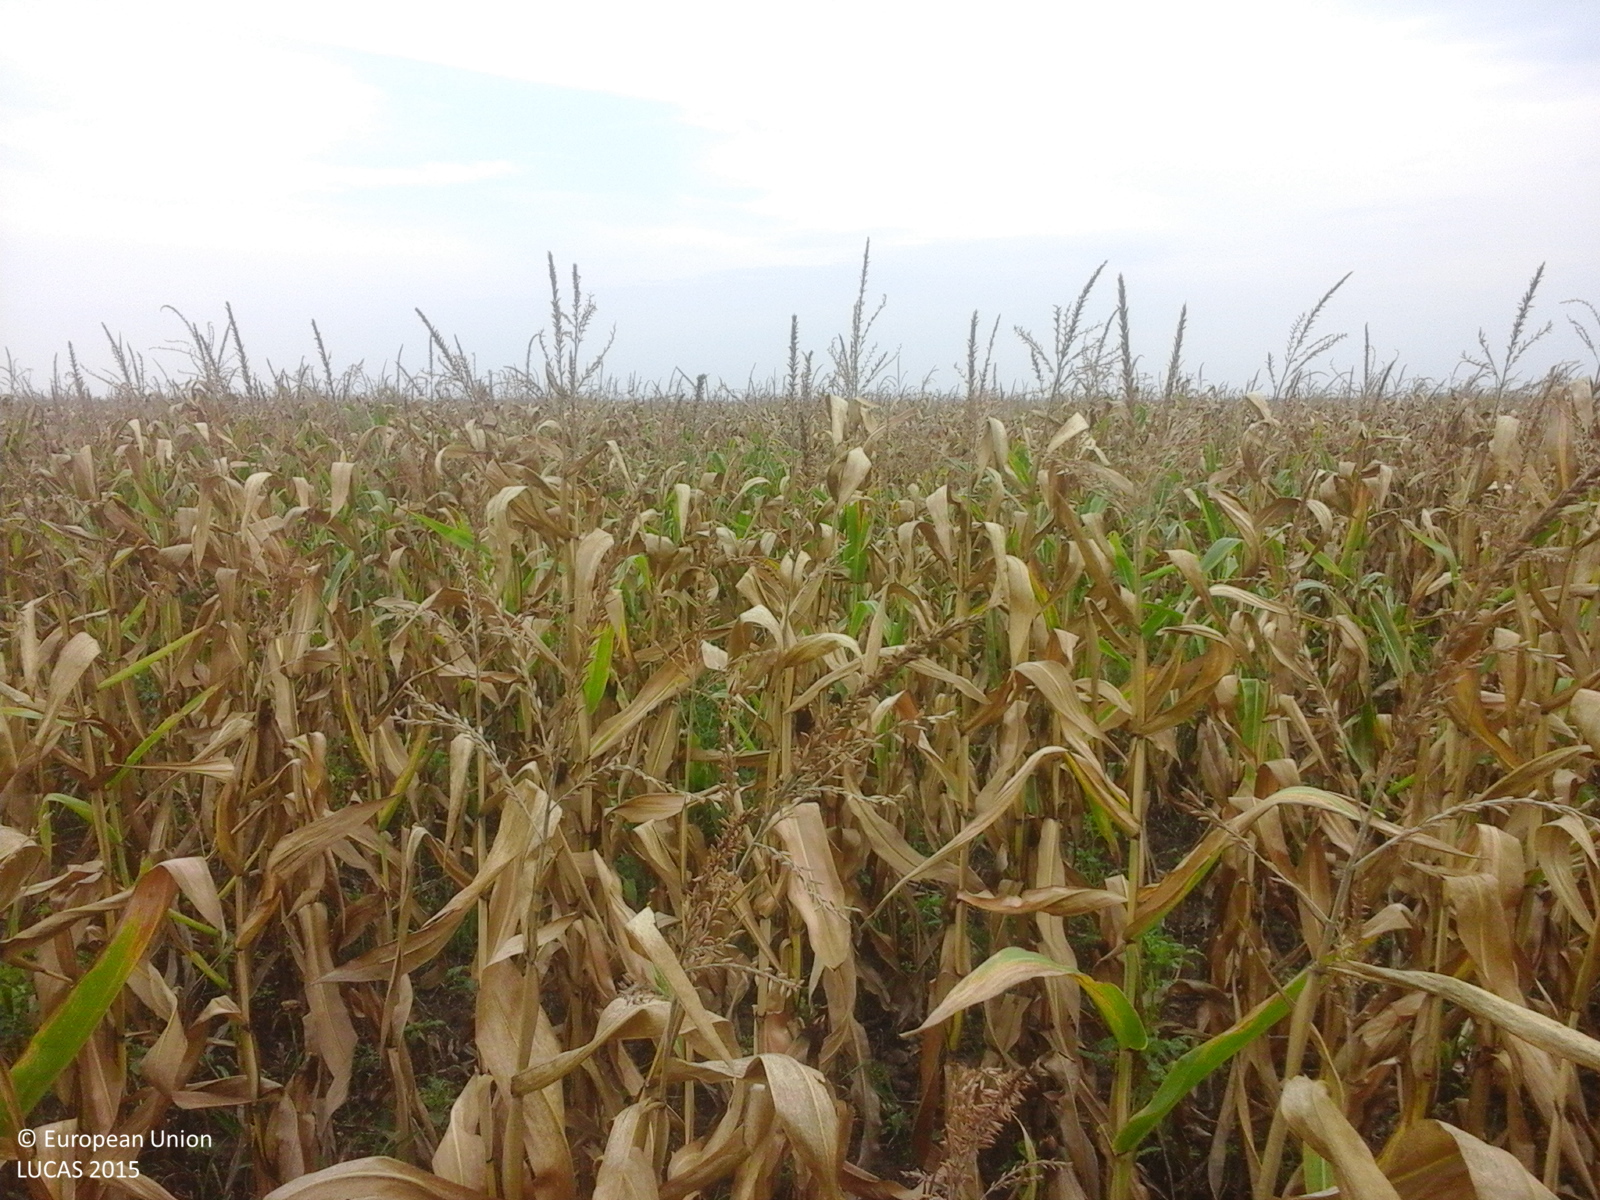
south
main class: Cropland
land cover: Maize
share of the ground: > 75 %
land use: Agriculture (excluding fallow land and kitchen gardens)
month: August
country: RO
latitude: 46.3419
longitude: 21.3781
